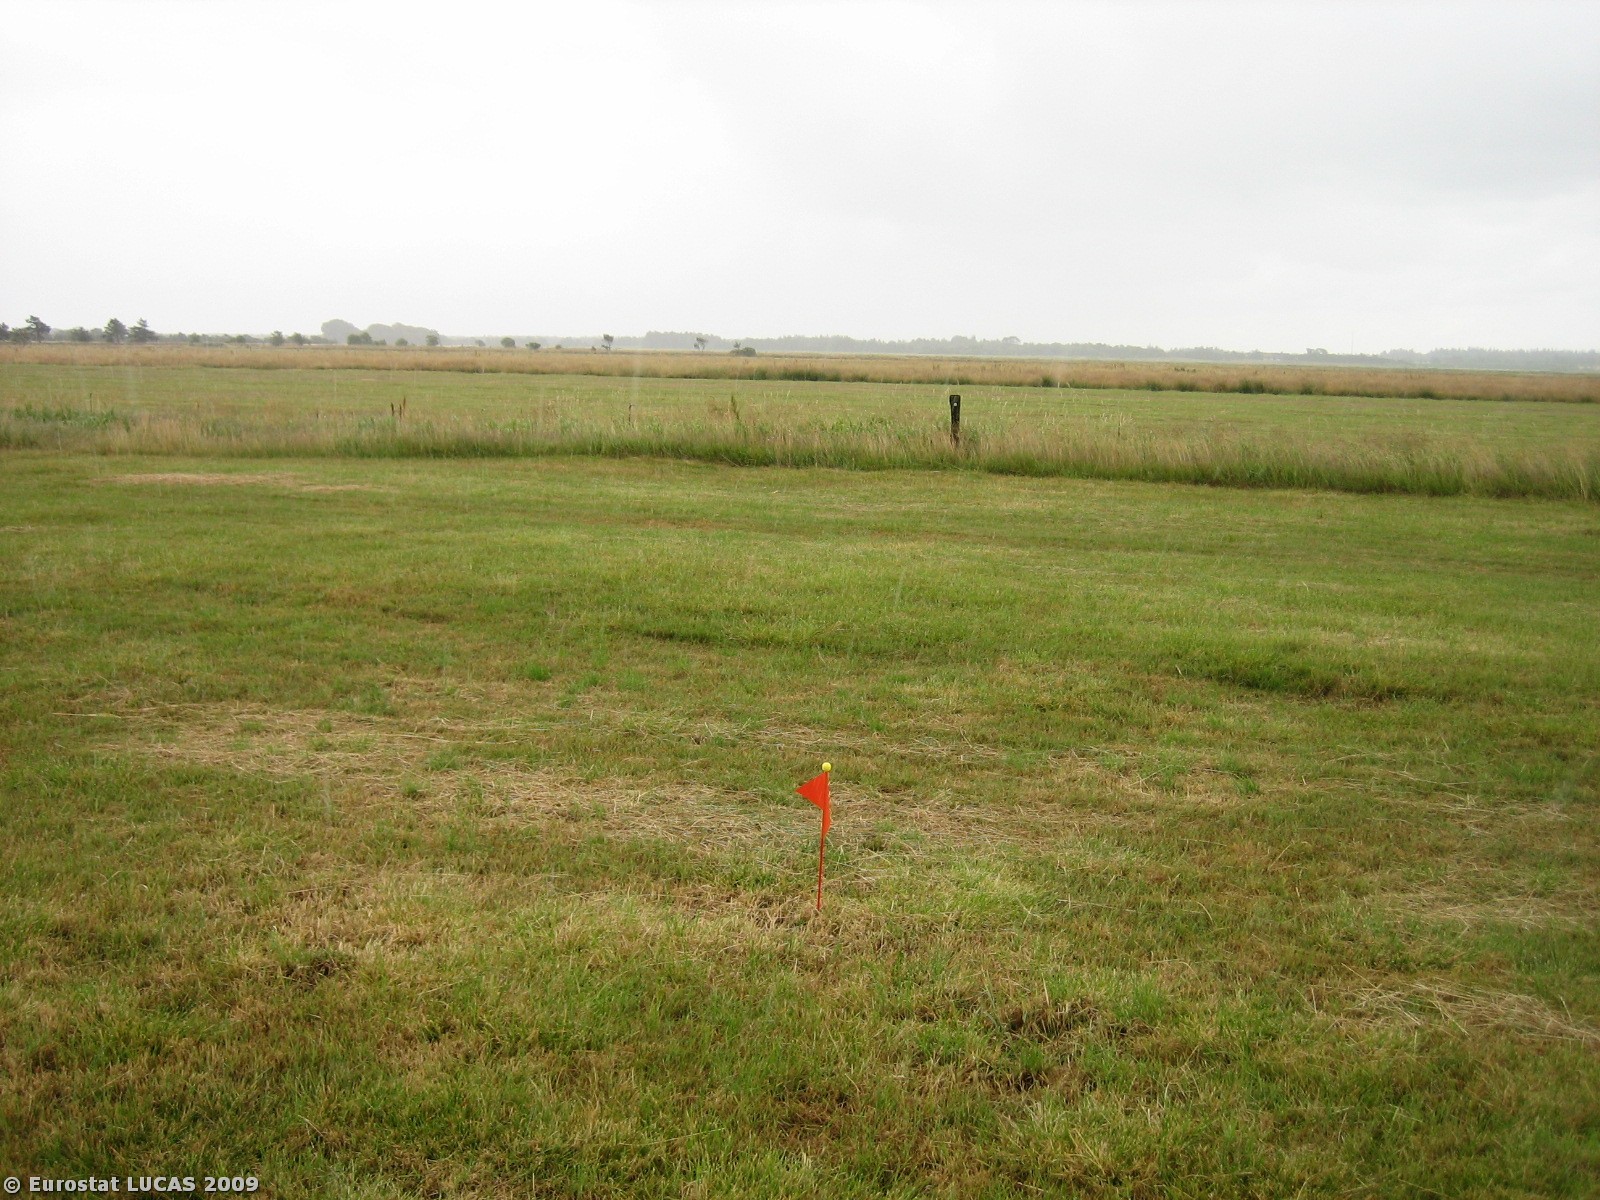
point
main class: Grassland
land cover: Grassland without tree/shrub cover
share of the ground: > 75 %
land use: Agriculture (excluding fallow land and kitchen gardens)
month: July
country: DK
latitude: 55.6020
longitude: 8.3667
